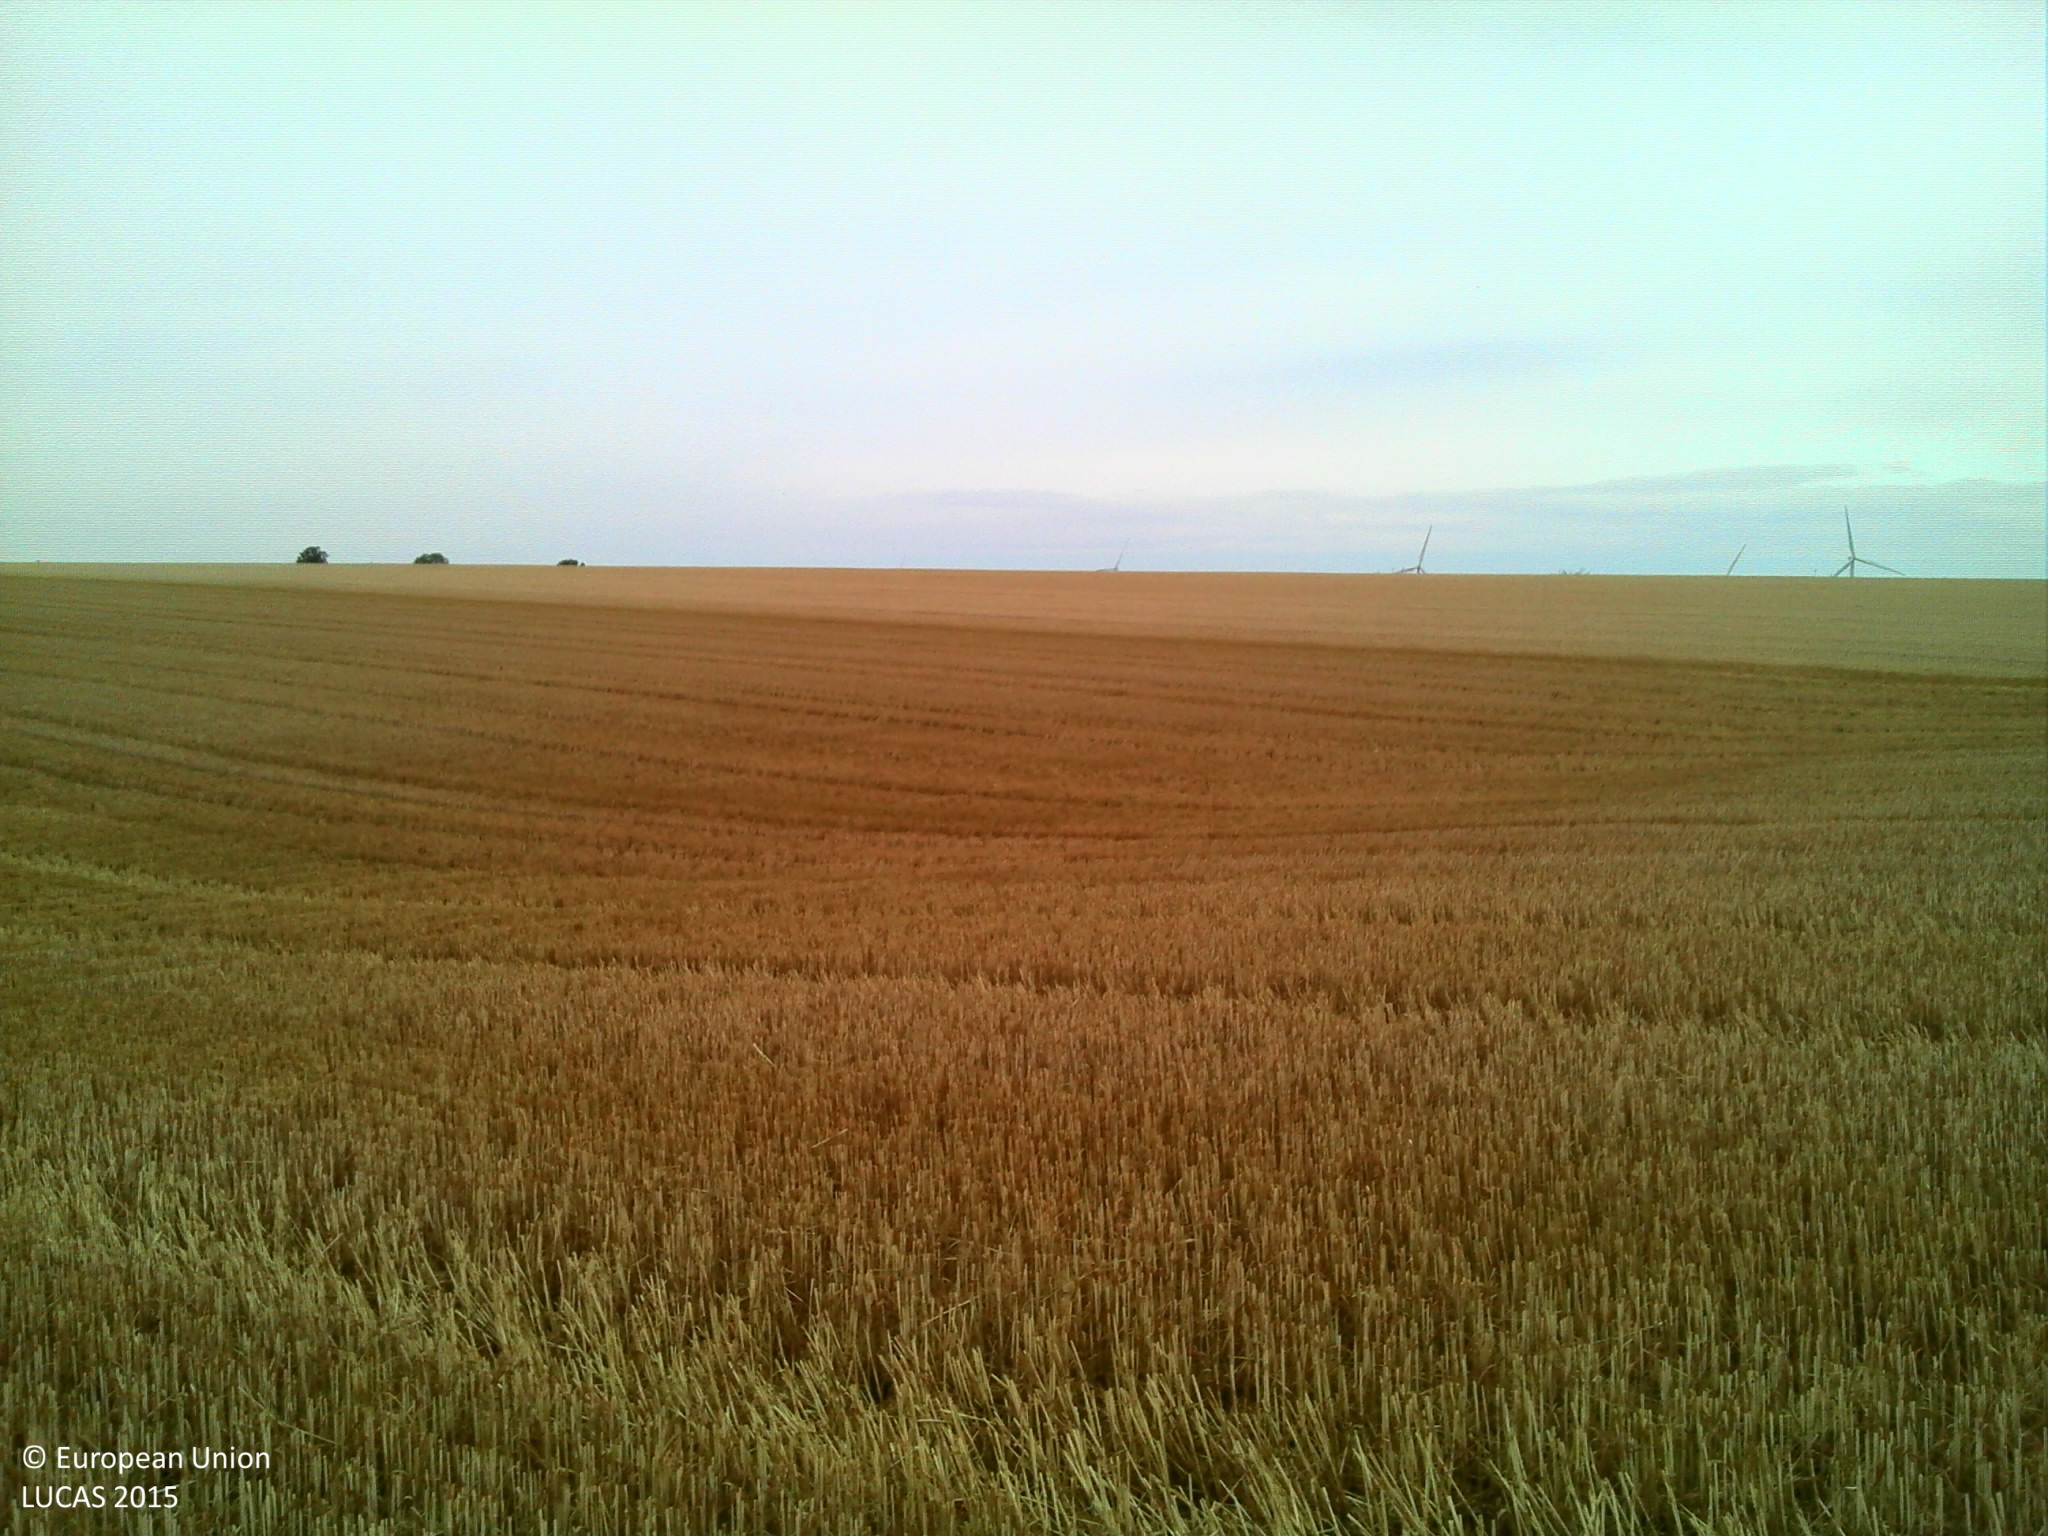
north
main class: Cropland
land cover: Common wheat
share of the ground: > 75 %
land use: Agriculture (excluding fallow land and kitchen gardens)
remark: Harvested field
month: July
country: FR
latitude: 48.8632
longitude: 4.1752
